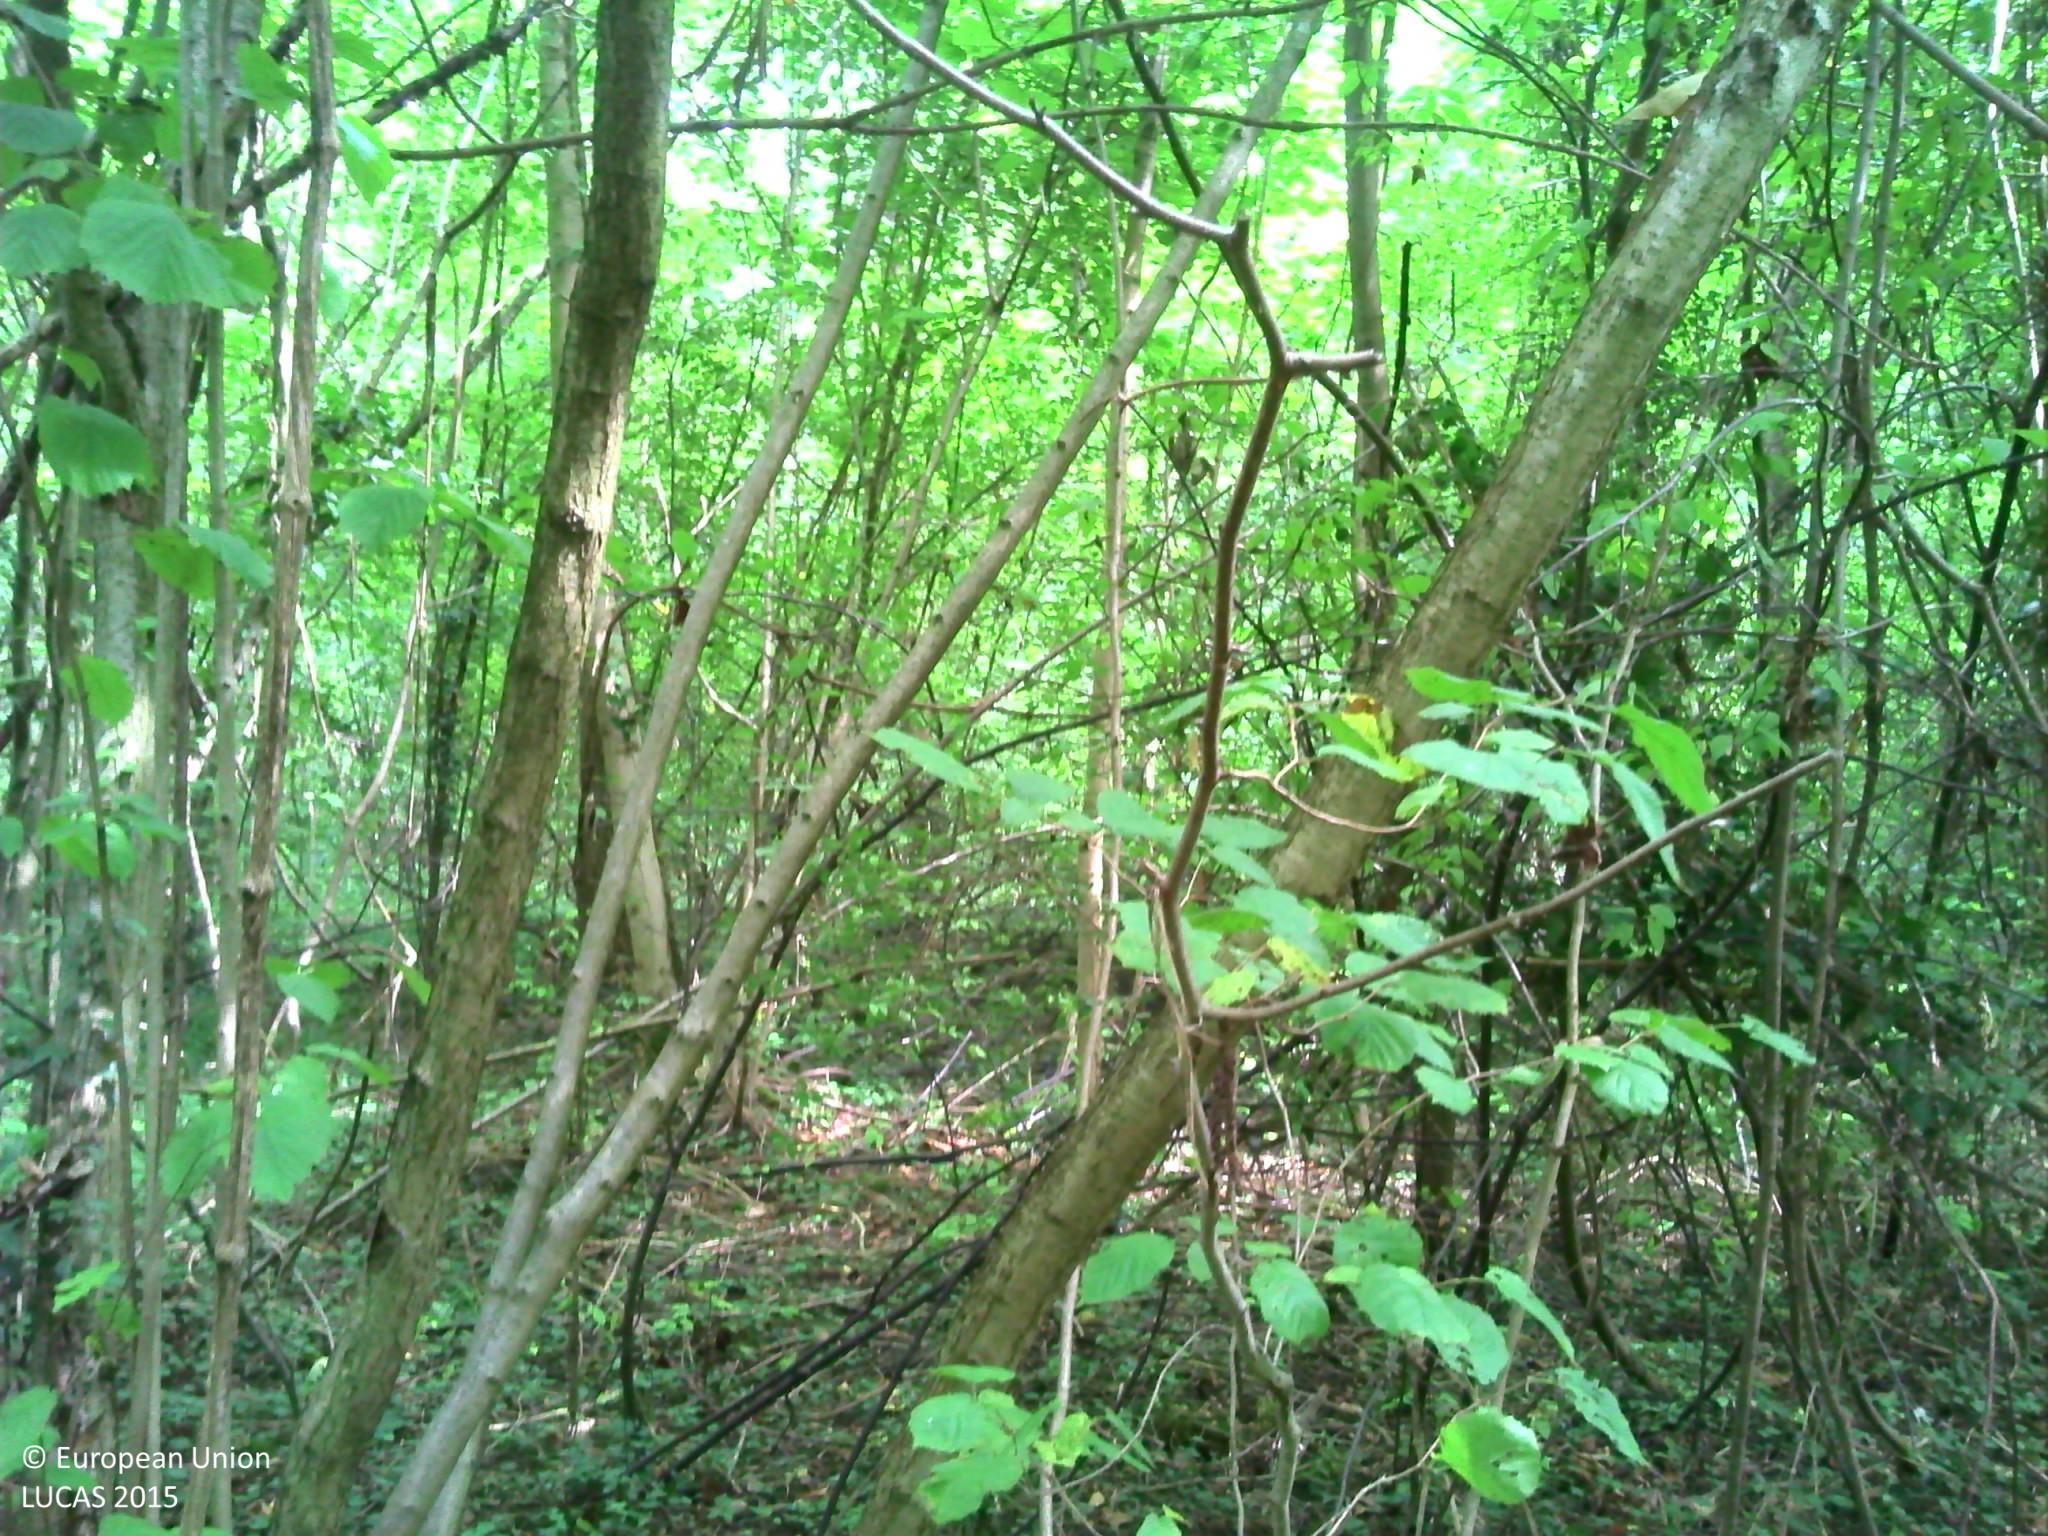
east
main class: Woodland
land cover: Broadleaved woodland
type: mesophytic deciduous forest
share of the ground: > 75 %
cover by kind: broadleaved forest trees 95 %, herbaceous plants 5 %
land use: Forestry
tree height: > 5 m
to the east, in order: Broadleaved woodland; Tracks; Broadleaved woodland
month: August
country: FR
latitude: 48.5064
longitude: 7.7404
